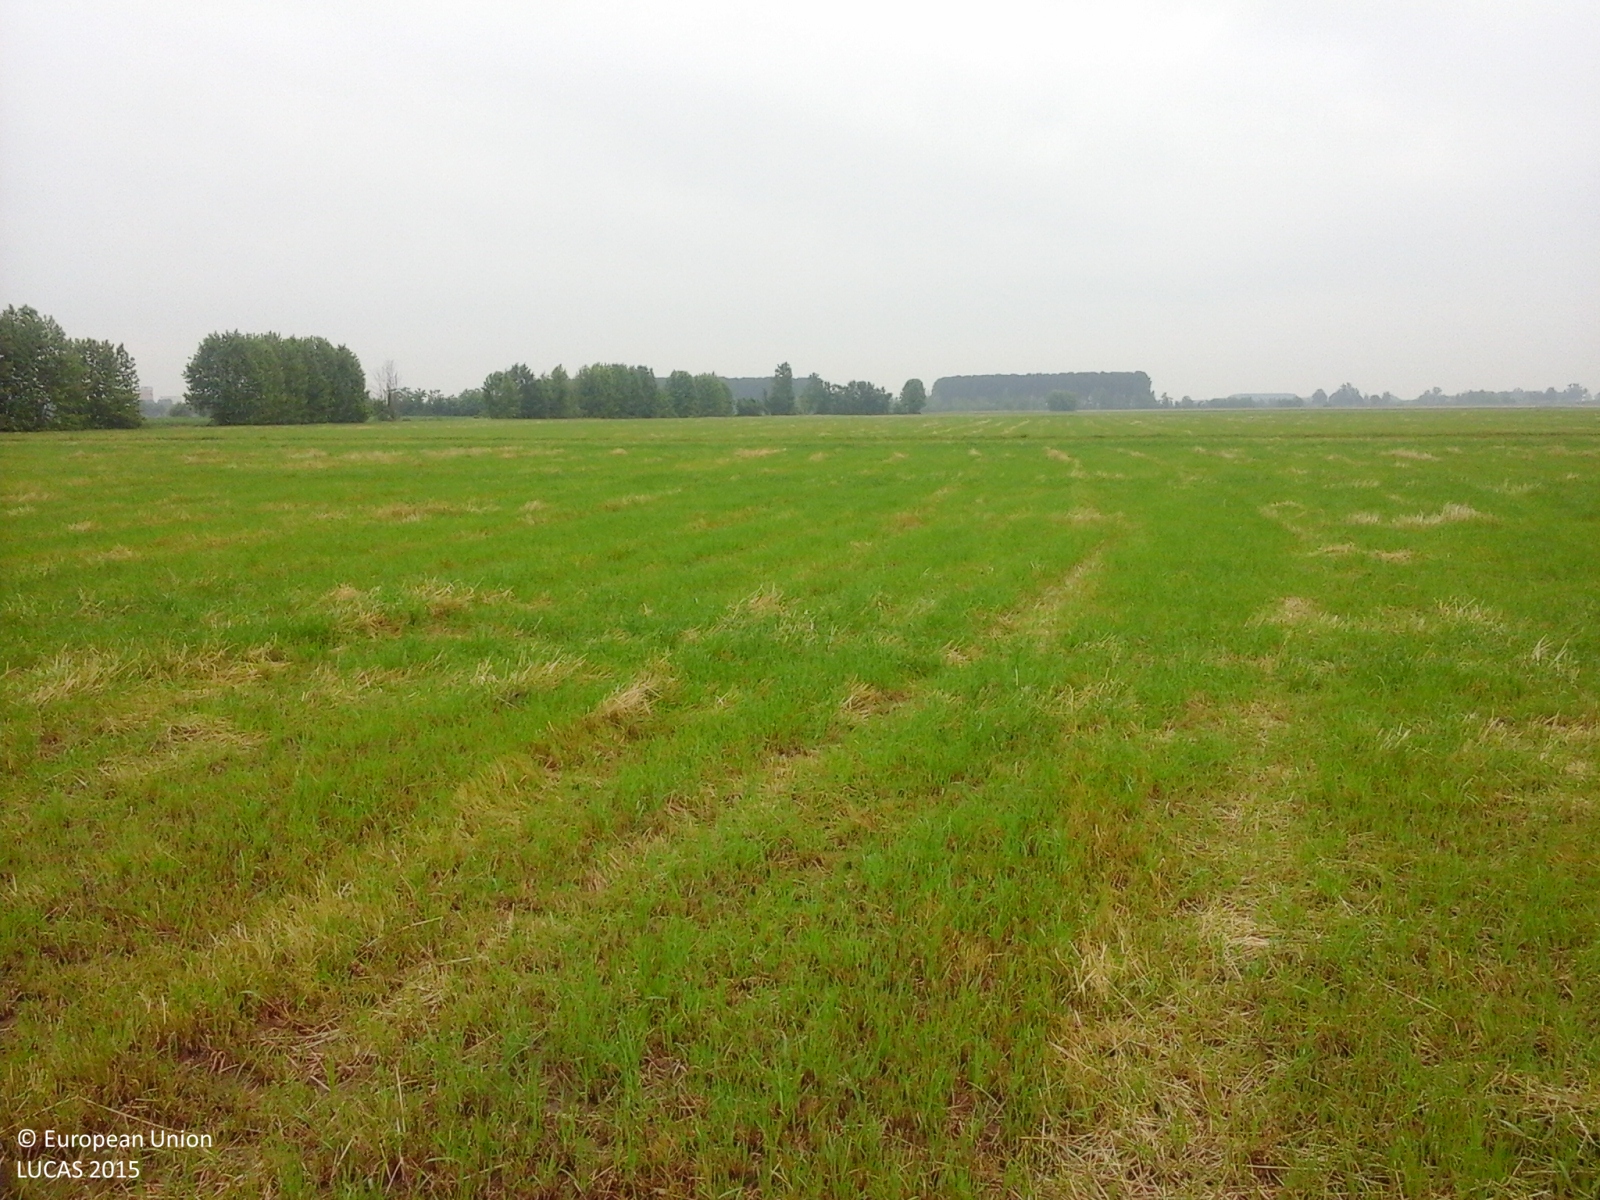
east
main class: Cropland
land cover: Temporary grasslands
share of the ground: > 75 %
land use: Agriculture (excluding fallow land and kitchen gardens)
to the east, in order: Temporary grasslands; Ditches and canals; Temporary grasslands
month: May
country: IT
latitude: 45.2160
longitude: 10.0635
